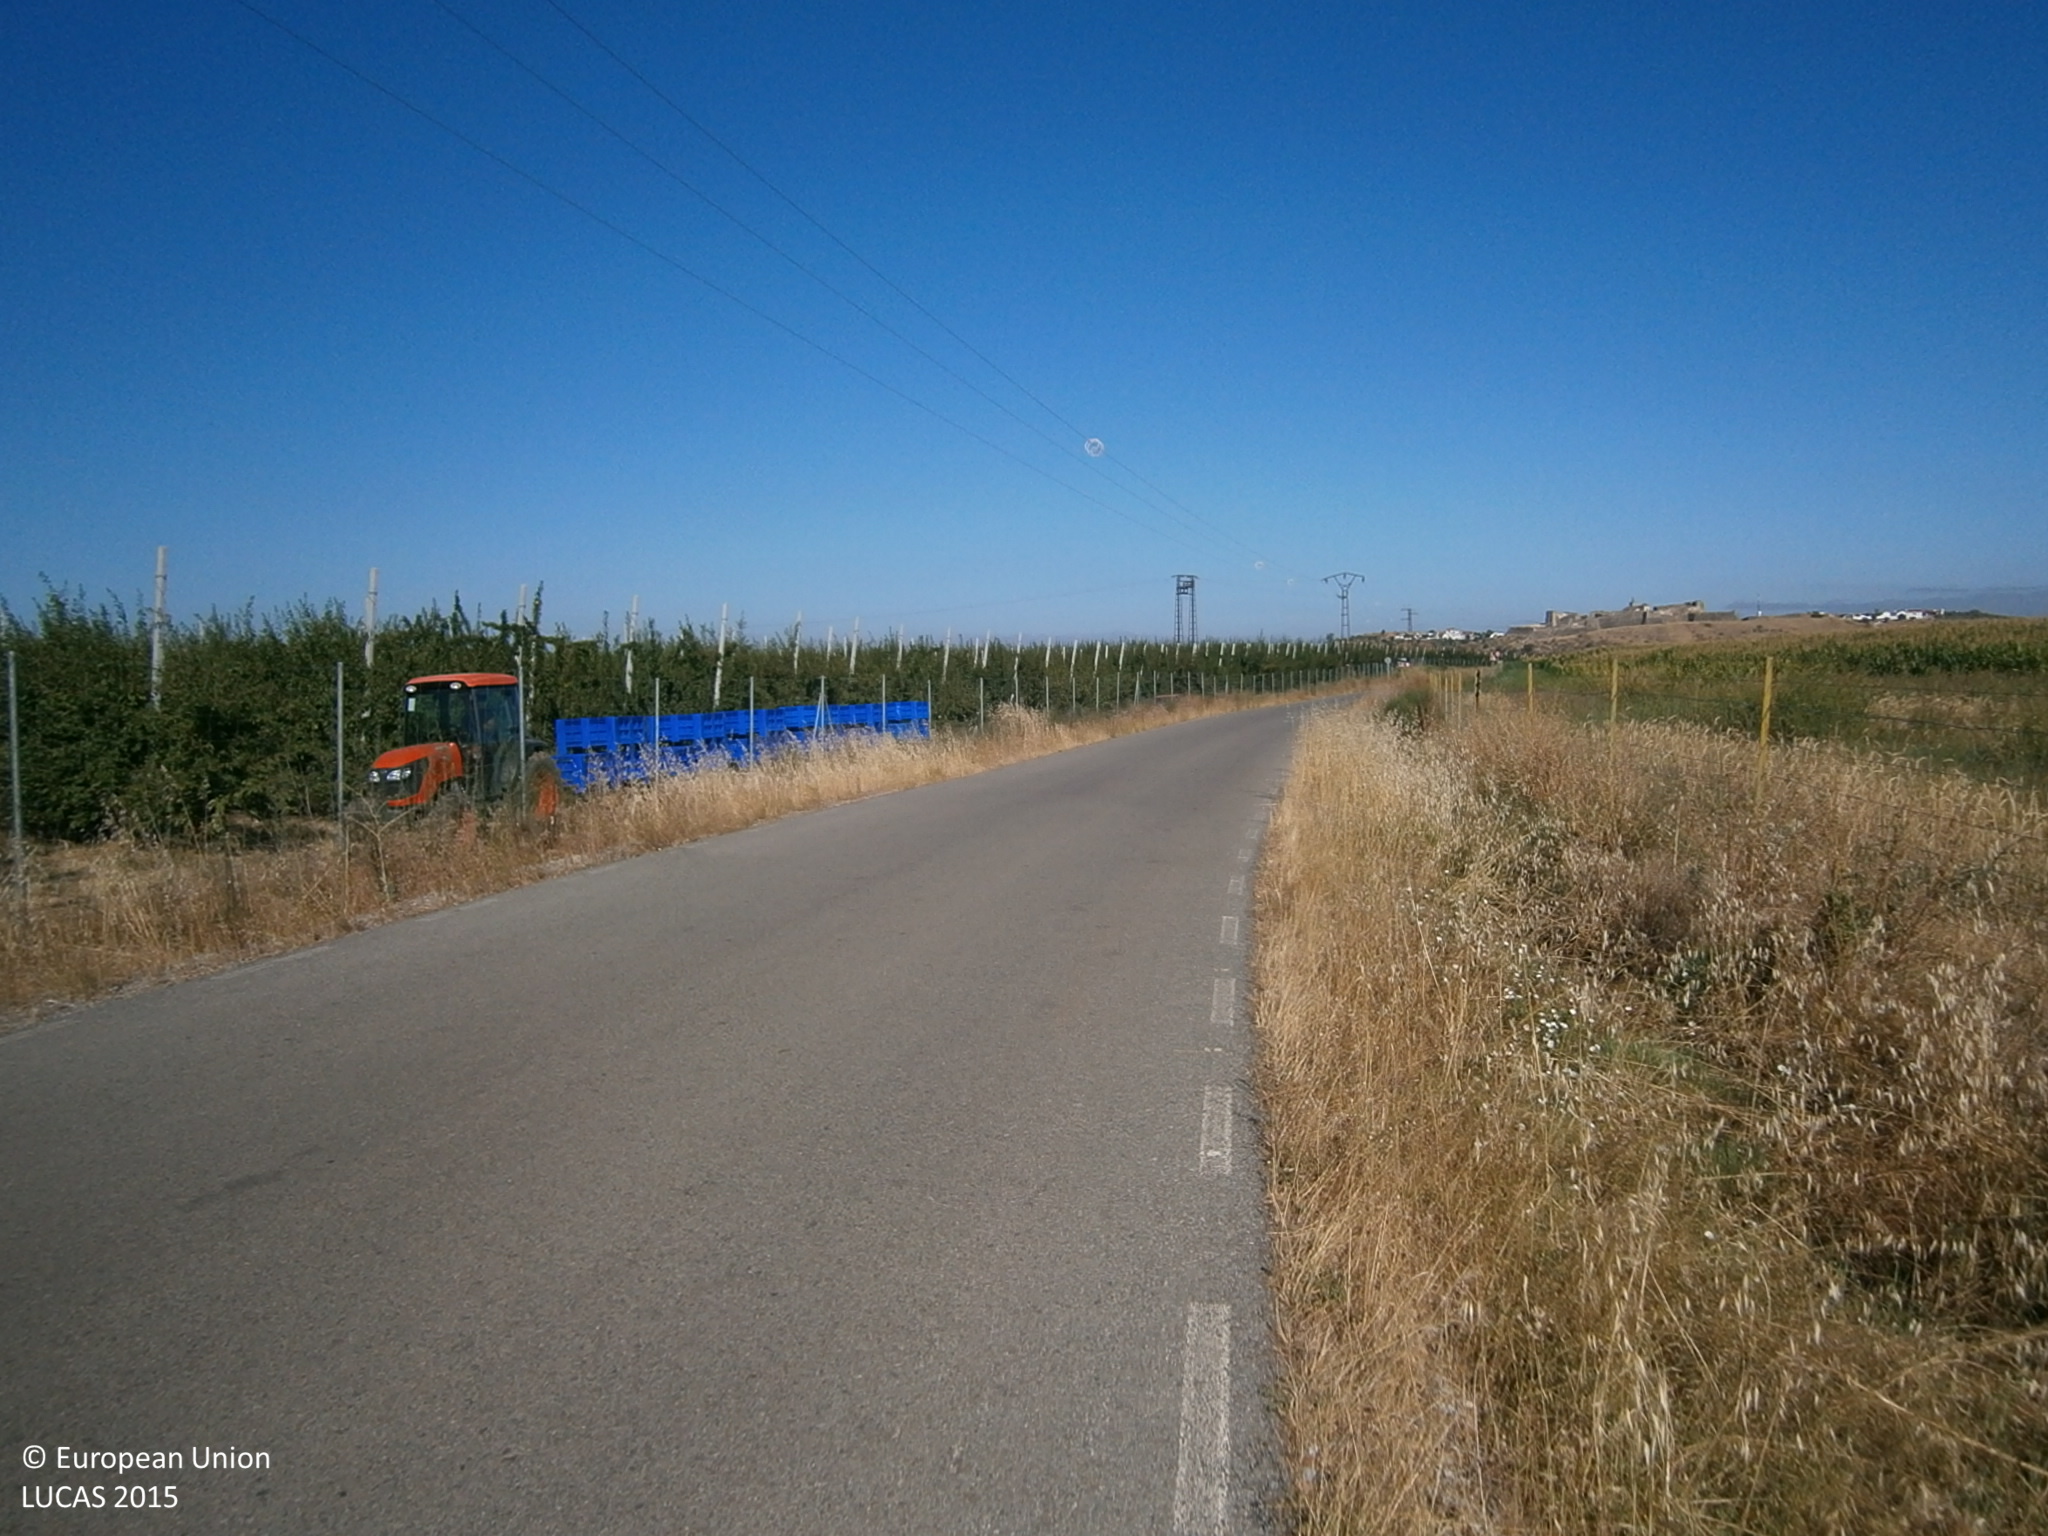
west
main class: Cropland
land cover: Maize
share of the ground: > 75 %
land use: Agriculture (excluding fallow land and kitchen gardens)
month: July
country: ES
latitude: 38.7311
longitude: -7.2240
